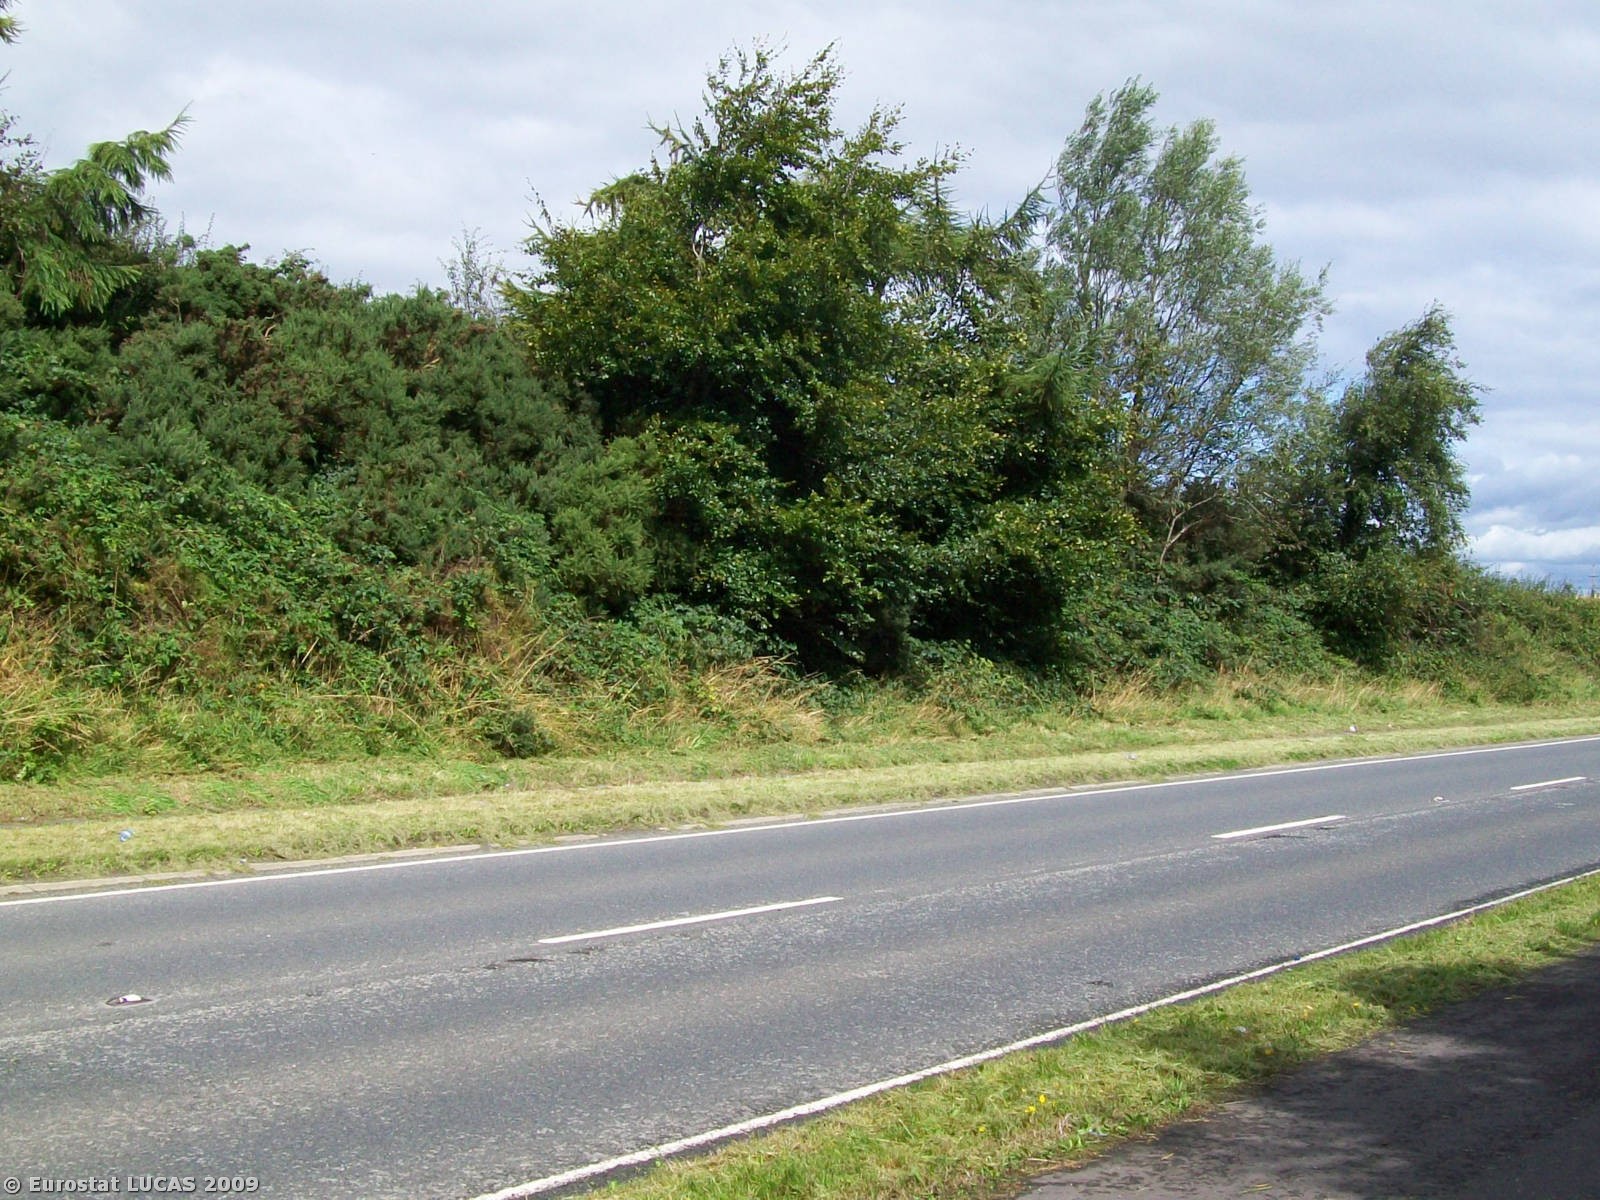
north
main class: Artificial land
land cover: Non built-up linear features
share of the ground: > 75 %
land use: Road transport
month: August
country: GB
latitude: 54.3901
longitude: -5.6708
